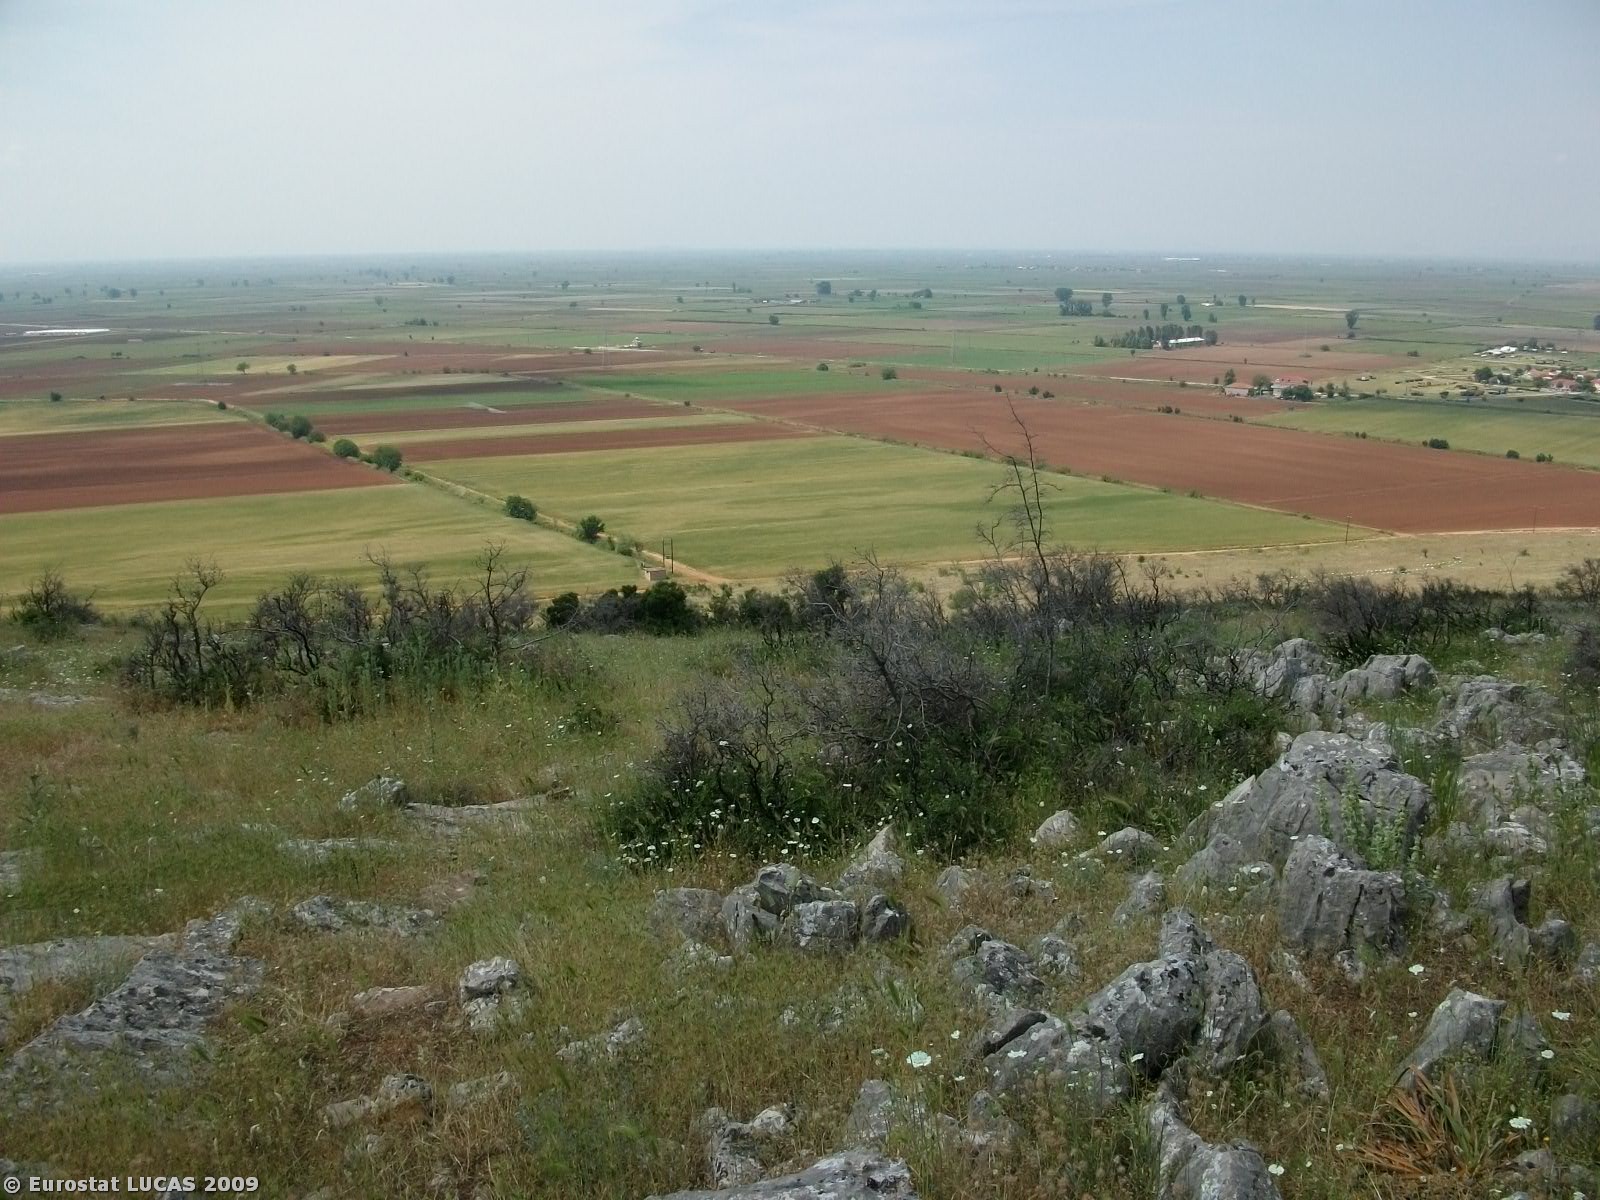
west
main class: Grassland
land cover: Grassland with sparse tree/shrub cover
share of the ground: > 75 %
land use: Agriculture (excluding fallow land and kitchen gardens)
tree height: < 5 m
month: May
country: GR
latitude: 39.2493
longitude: 22.3248
